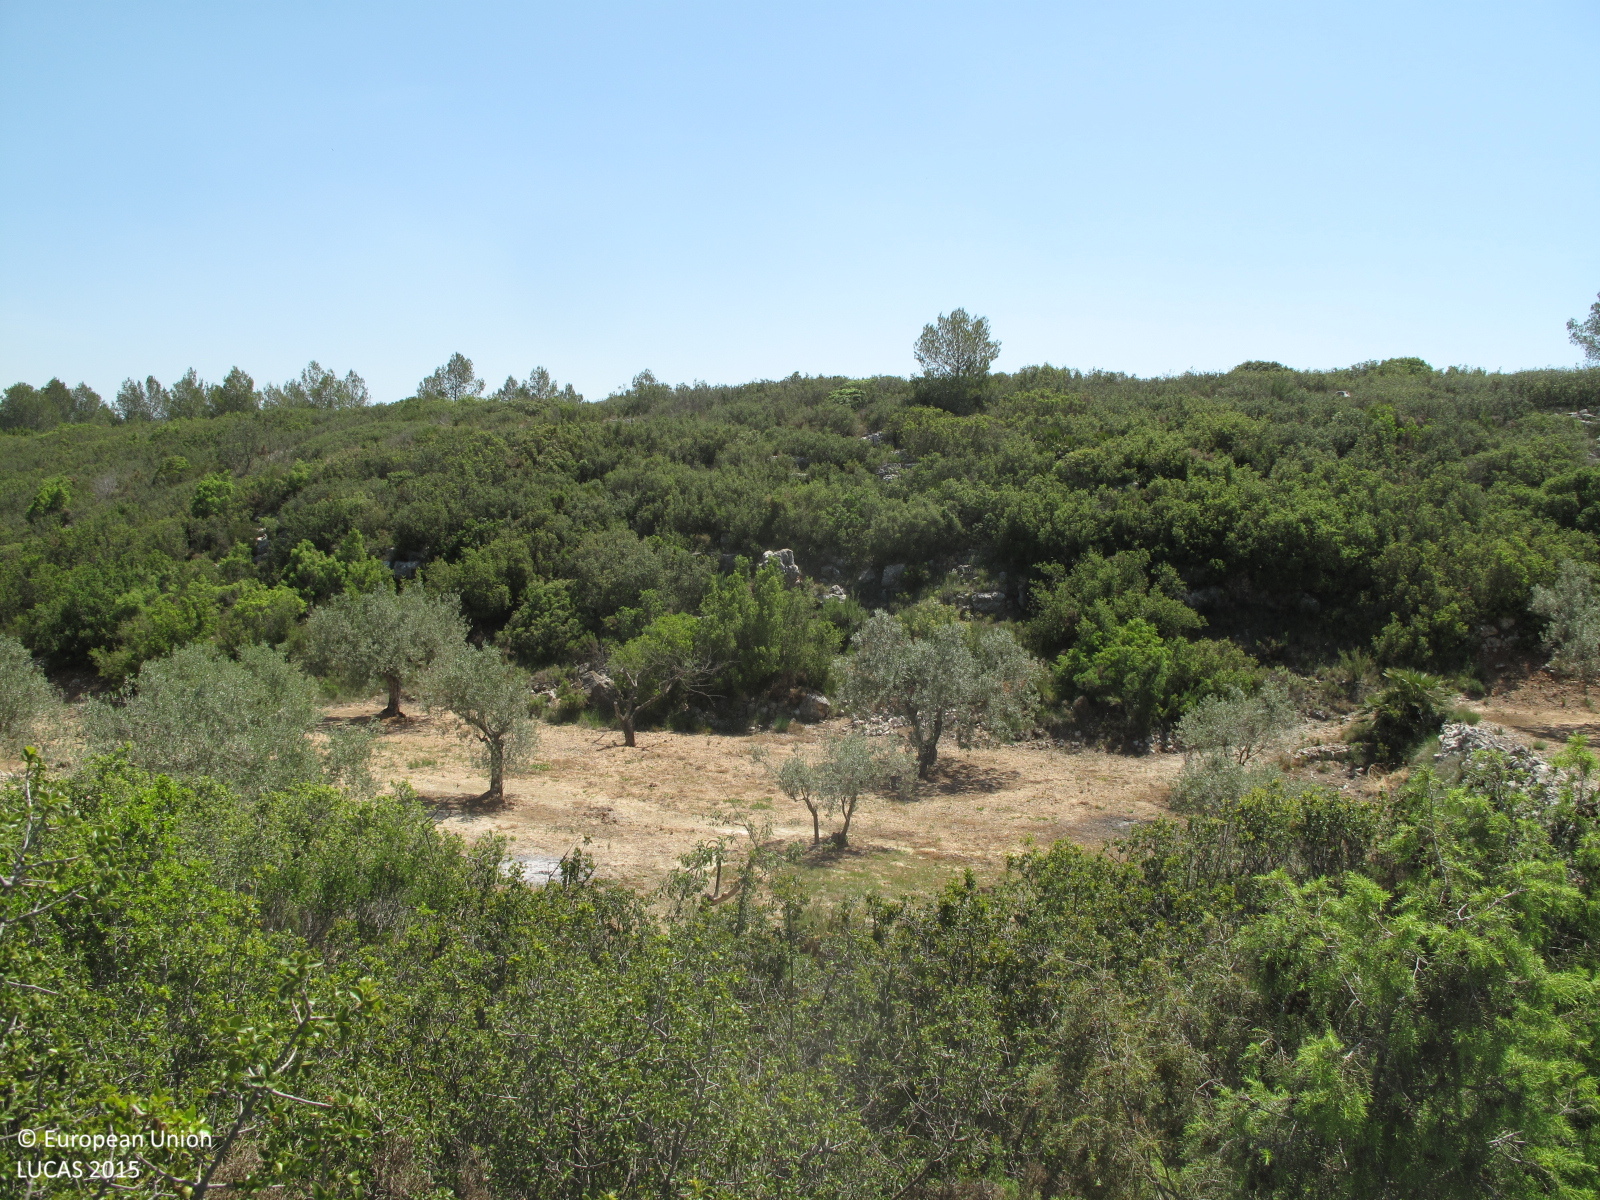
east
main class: Shrubland
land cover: Shrubland with sparse tree cover
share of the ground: > 75 %
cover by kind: shrubs 80 %, consolidated bare surface 15 %, broadleaved forest trees 5 %
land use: Semi-natural and natural areas not in use
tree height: < 5 m
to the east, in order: Shrubland with sparse tree cover; Olive groves; Dry stone walls; Olive groves; Shrubland without tree cover; Other bare soil; Paved roads, cycling and walking lanes; Other bare soil; Pine dominated coniferous woodland
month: May
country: ES
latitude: 38.9467
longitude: -0.7351
